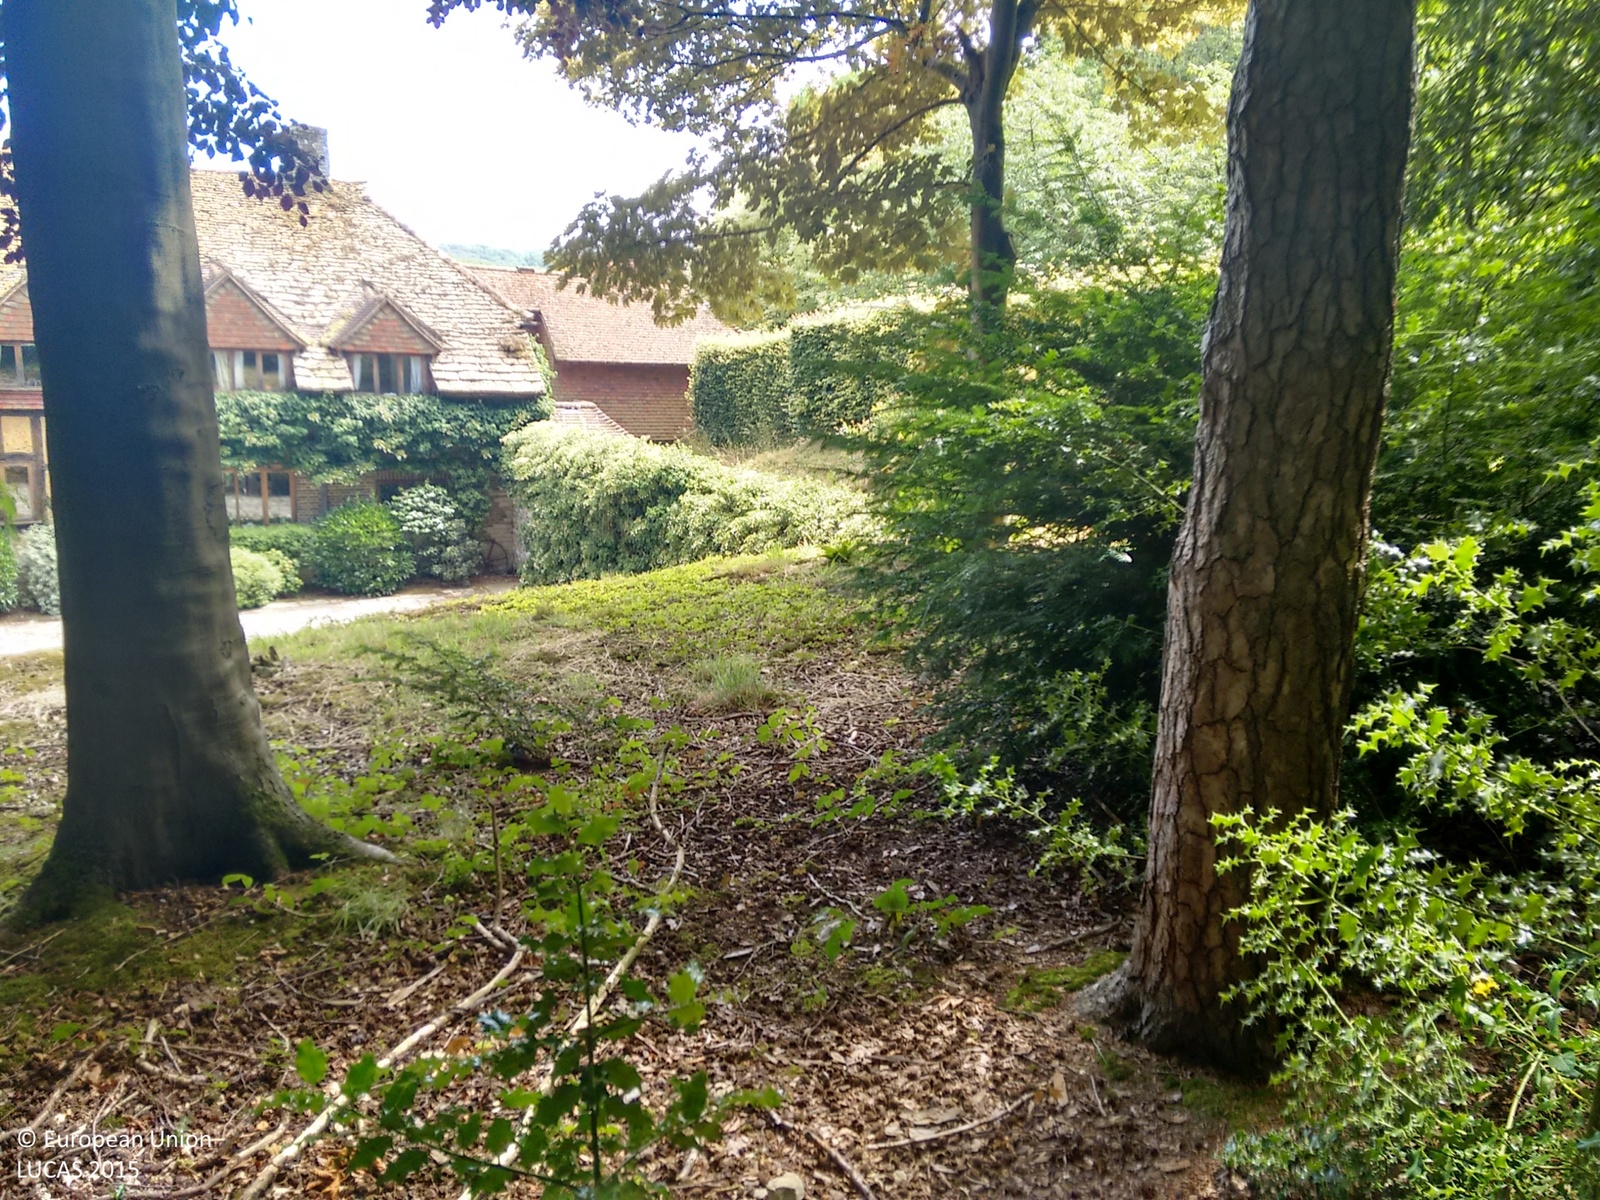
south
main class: Woodland
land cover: Broadleaved woodland
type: beech forest
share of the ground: > 75 %
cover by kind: broadleaved forest trees 100 %
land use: Residential
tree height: > 5 m
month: July
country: GB
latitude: 50.9836
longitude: -0.9119
